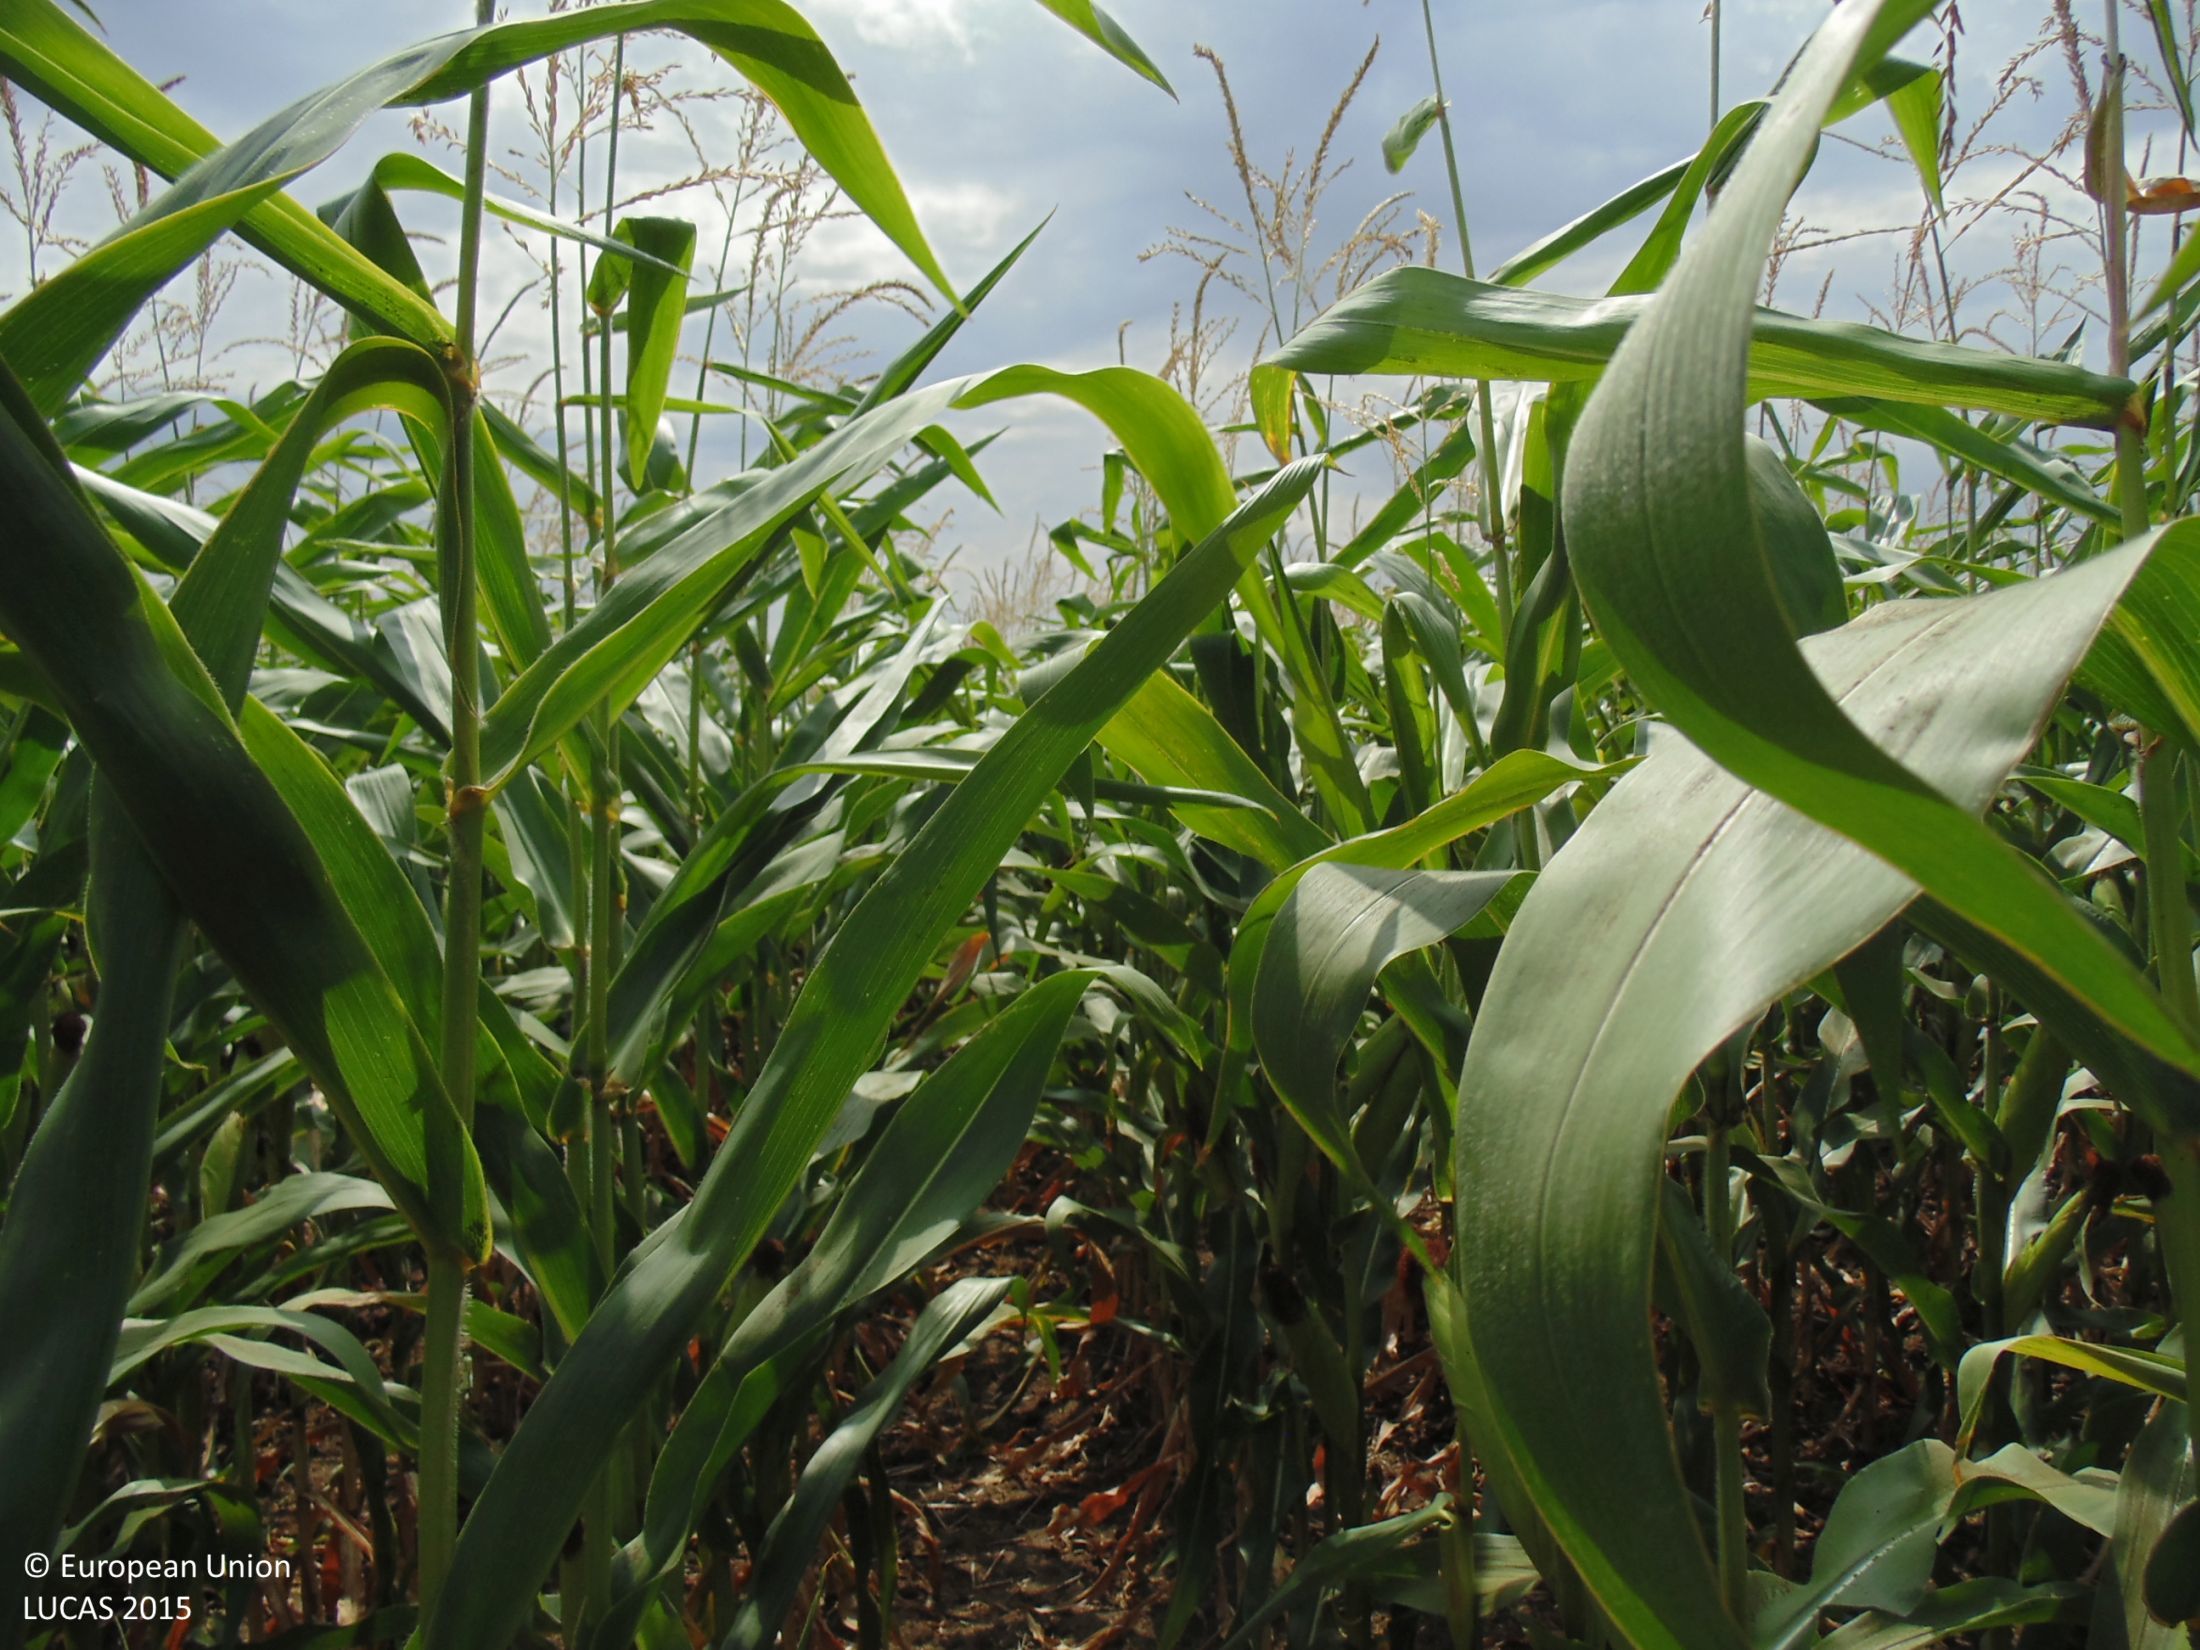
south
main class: Cropland
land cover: Maize
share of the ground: > 75 %
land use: Agriculture (excluding fallow land and kitchen gardens)
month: August
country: BG
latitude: 43.7661
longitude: 28.1534
